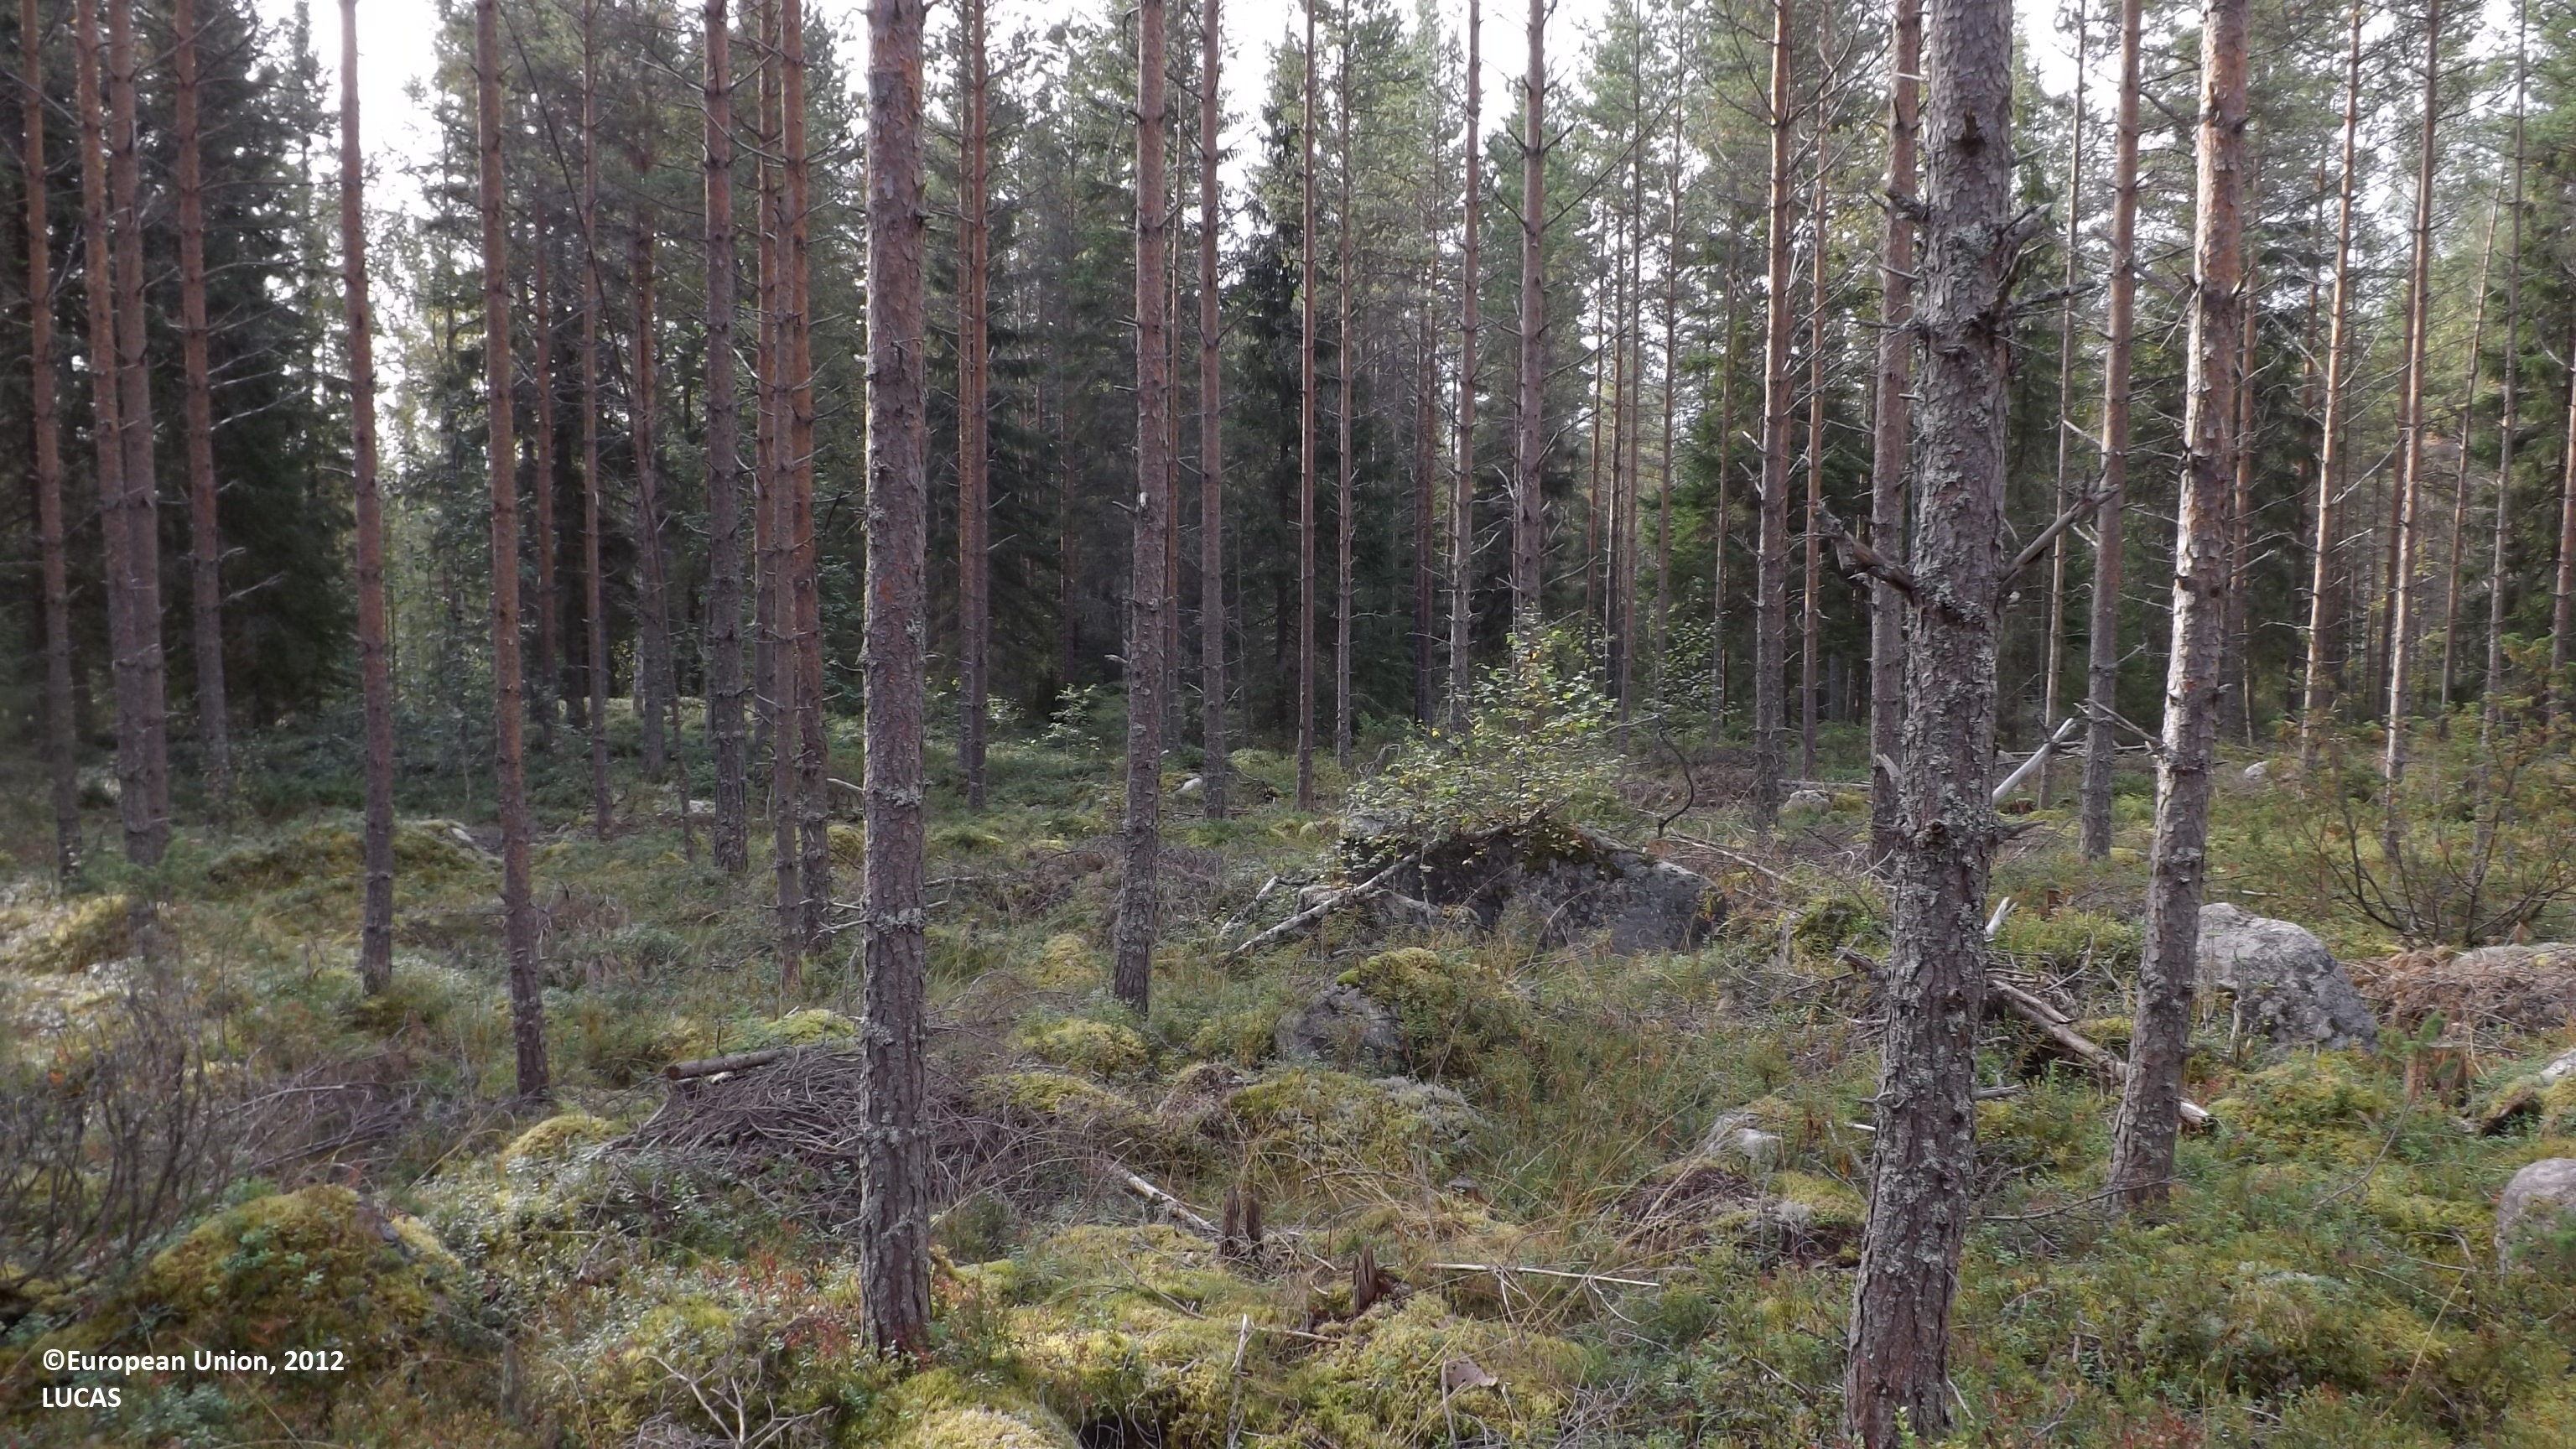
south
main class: Woodland
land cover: Pine dominated coniferous woodland
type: boreal forest
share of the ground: 25 - 50 %
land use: Forestry
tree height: > 5 m
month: August
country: FI
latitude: 63.7595
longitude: 23.7470
